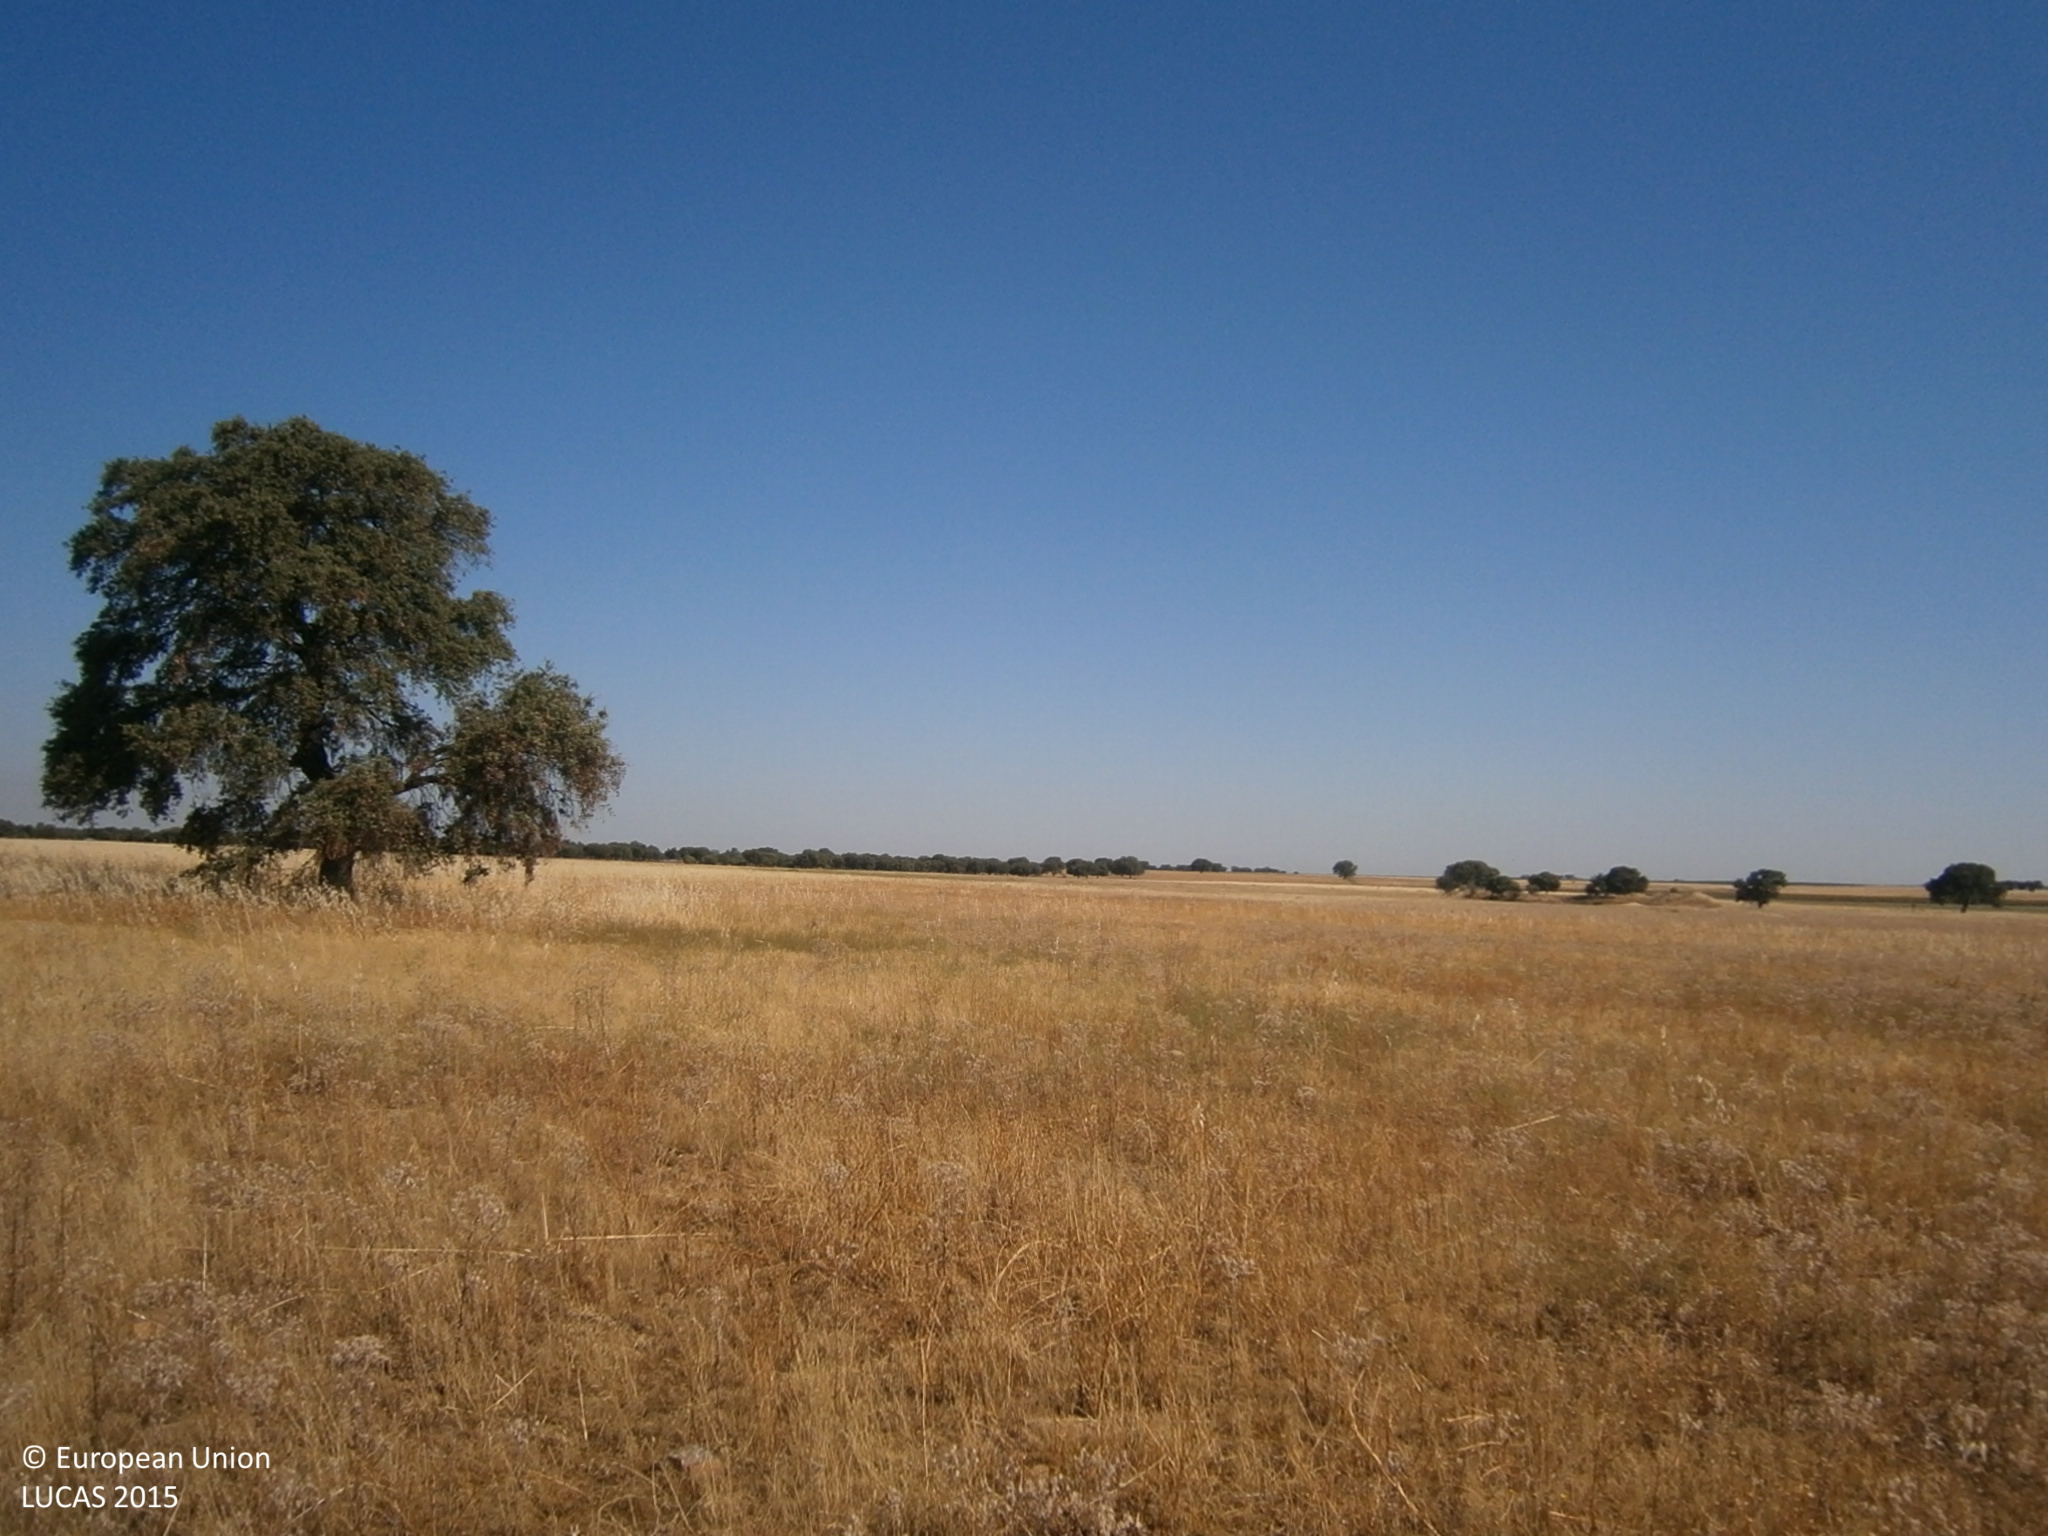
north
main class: Grassland
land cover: Spontaneously vegetated surfaces
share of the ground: > 75 %
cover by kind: herbaceous plants 95 %, unconsolidated bare surface 5 %
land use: Fallow land
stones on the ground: 10 - 25 %
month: June
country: ES
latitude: 38.6840
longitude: -6.7652
